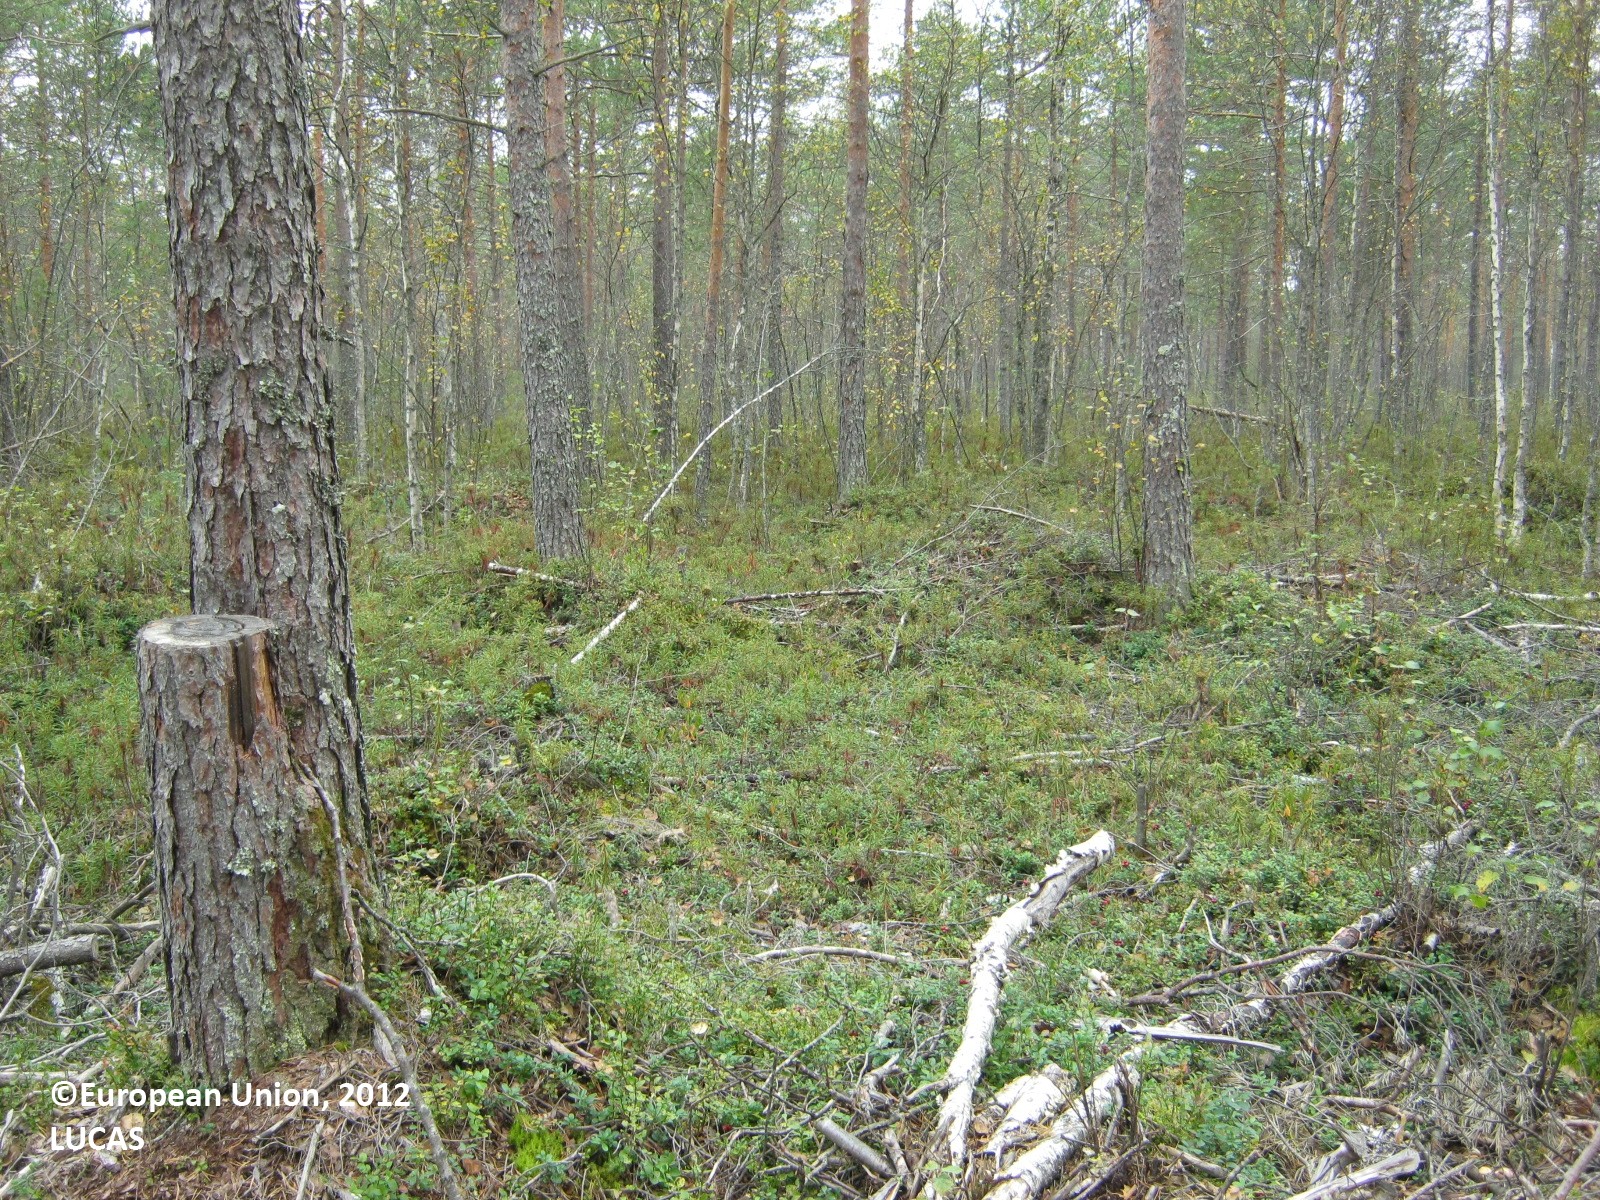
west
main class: Woodland
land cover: Pine dominated mixed woodland
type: boreal forest
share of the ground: 50 - 75 %
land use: Forestry
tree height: > 5 m
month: September
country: FI
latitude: 60.9965
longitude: 27.9656
